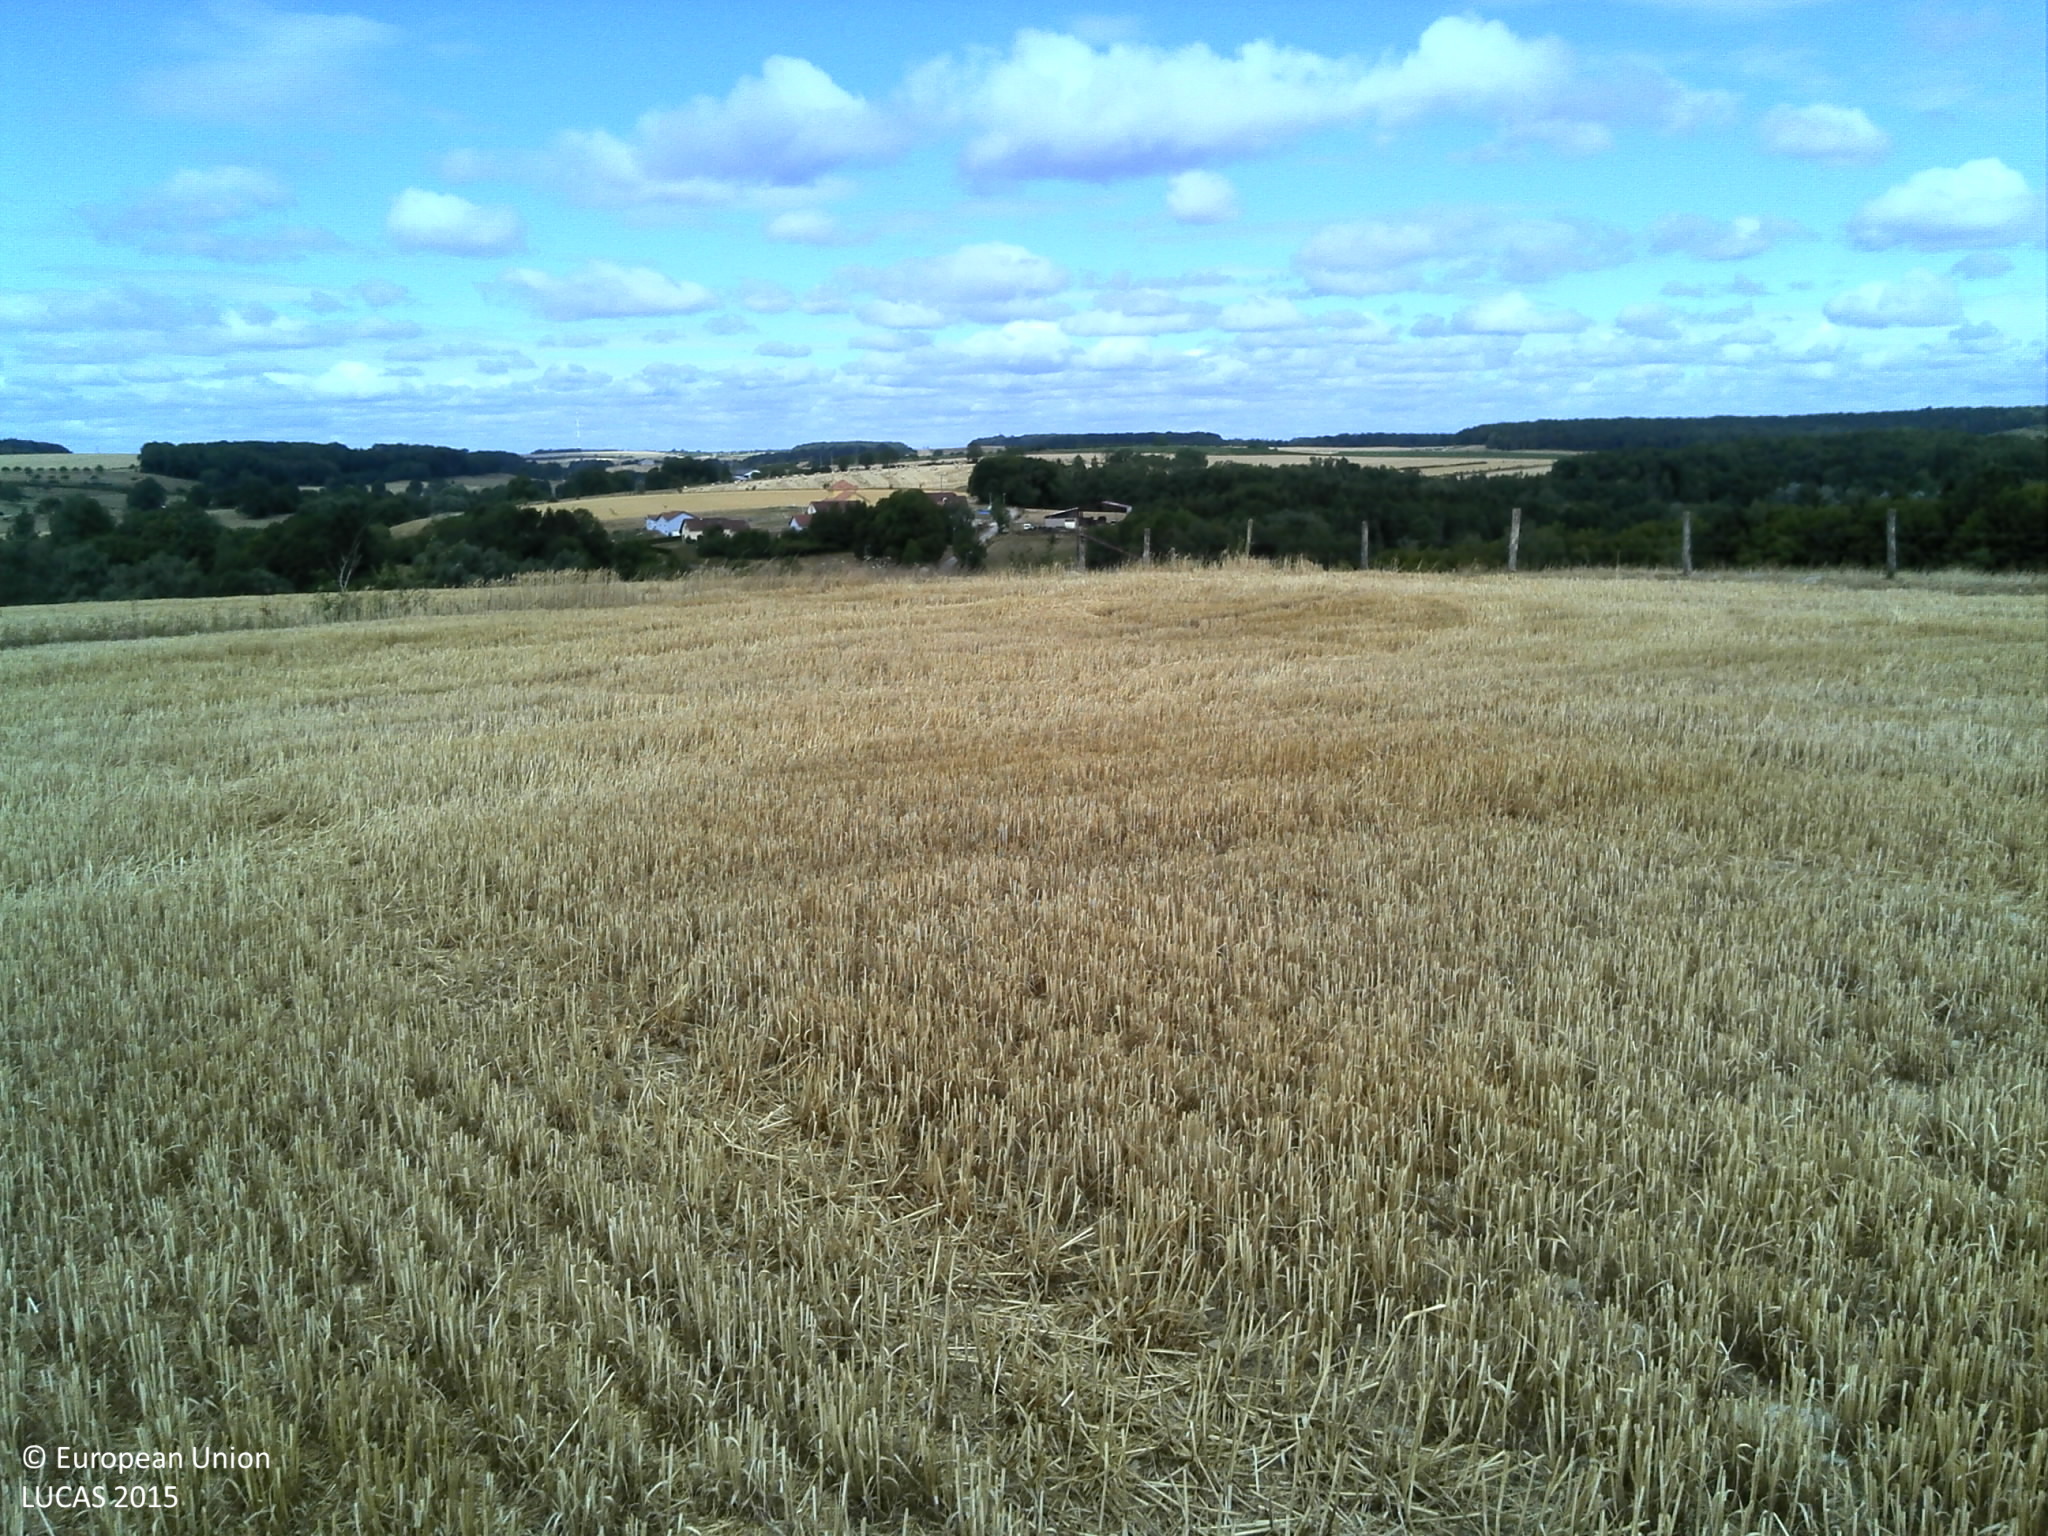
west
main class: Cropland
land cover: Durum wheat
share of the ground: > 75 %
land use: Agriculture (excluding fallow land and kitchen gardens)
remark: Harvested field
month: July
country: FR
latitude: 48.1561
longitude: 6.1424
